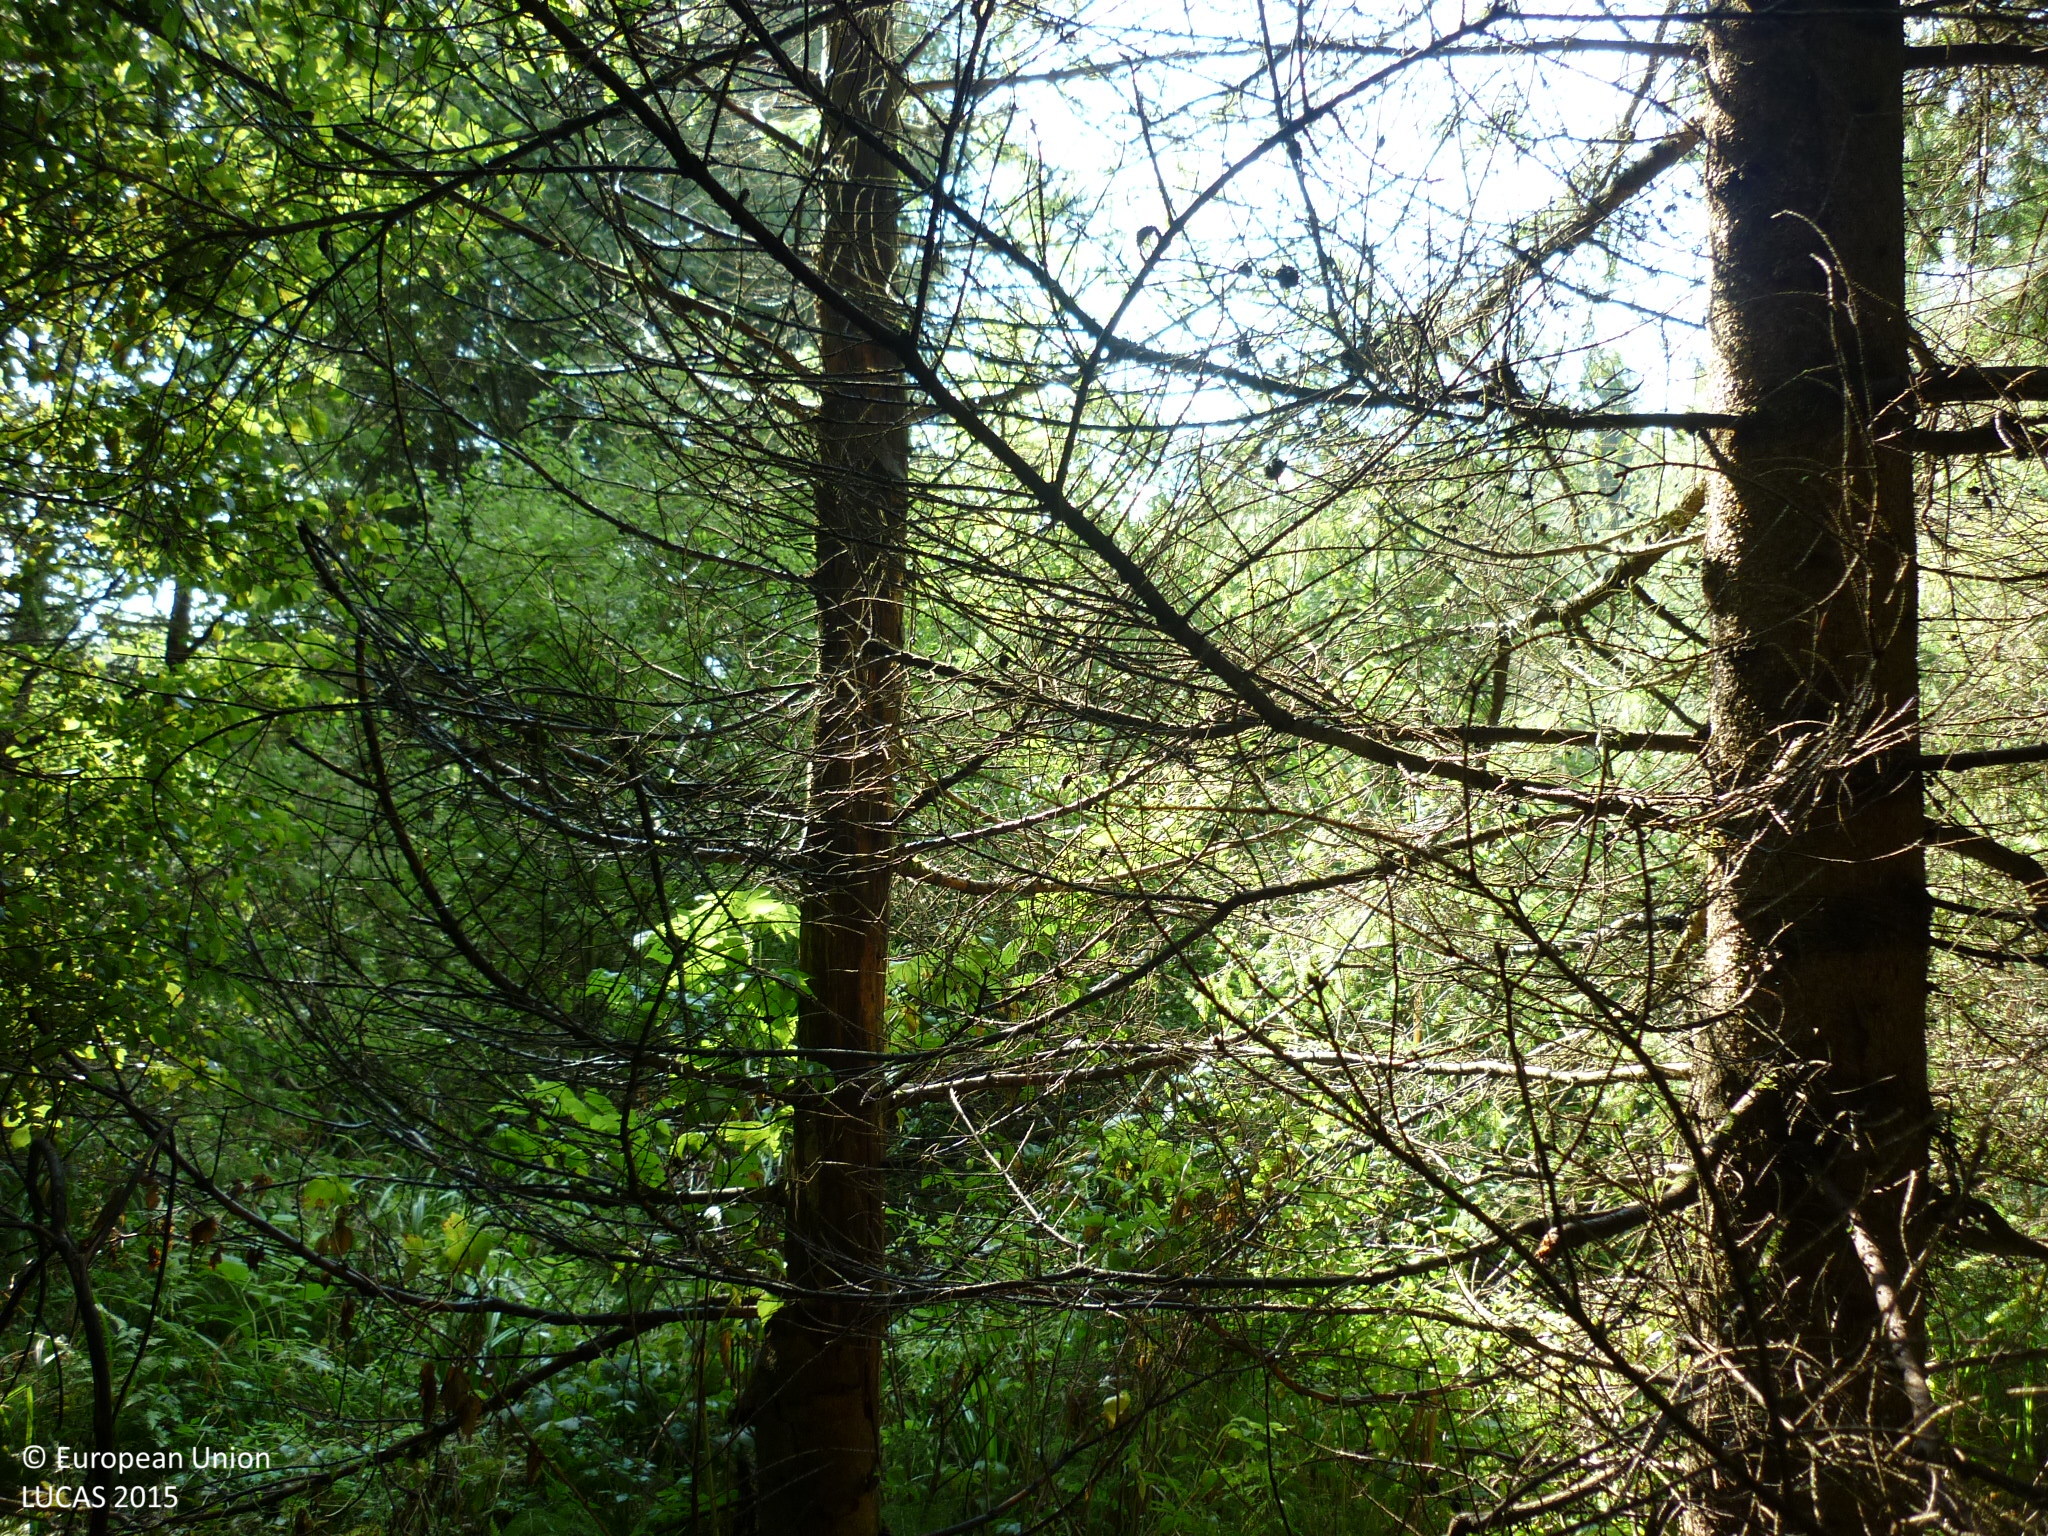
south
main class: Woodland
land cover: Spruce dominated mixed woodland
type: hemiboreal forest and nemoral coniferous forest and mixed broadleaved-coniferous forest
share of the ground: > 75 %
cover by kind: coniferous forest trees 75 %, broadleaved forest trees 25 %
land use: Forestry
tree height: > 5 m
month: September
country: AT
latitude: 49.0093
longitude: 15.0470
